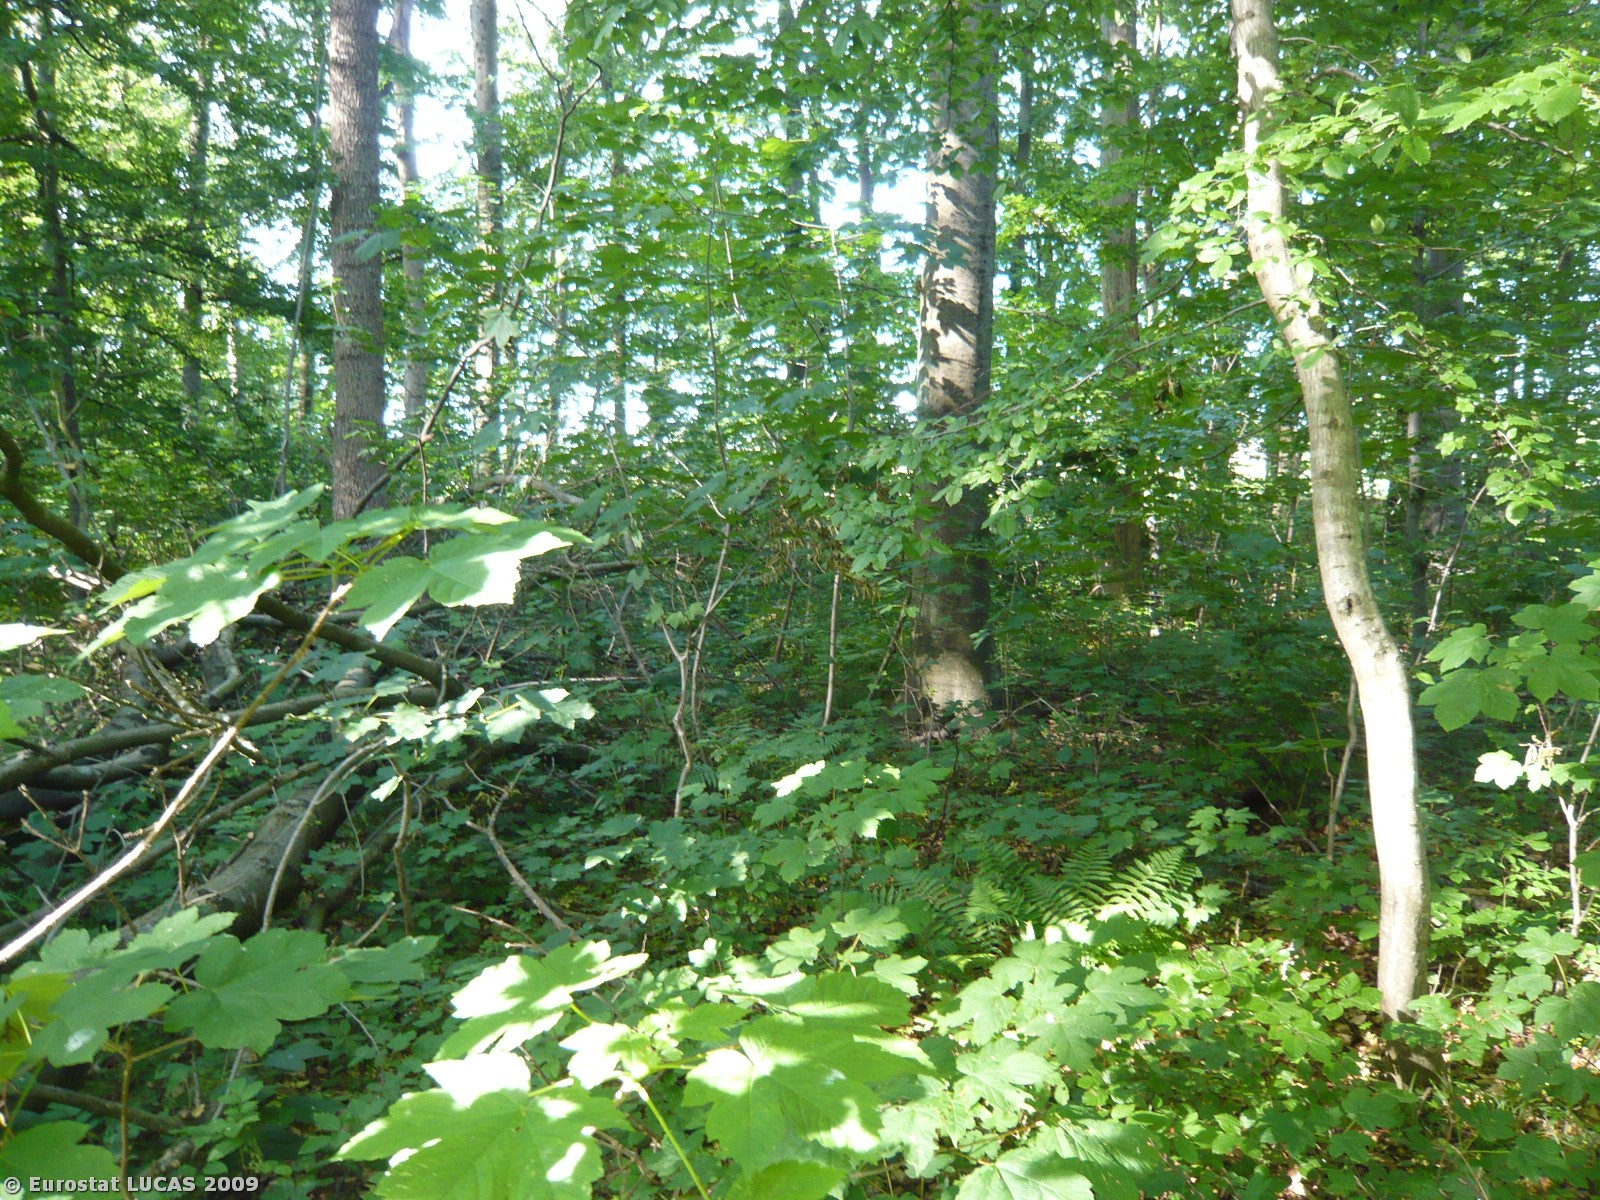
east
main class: Woodland
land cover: Broadleaved woodland
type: mesophytic deciduous forest
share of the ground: > 75 %
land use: Forestry
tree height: > 5 m
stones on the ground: < 10 %
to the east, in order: Broadleaved woodland; Grassland without tree/shrub cover; Tracks; Sugar beet
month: June
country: DK
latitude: 54.8327
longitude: 11.3224
